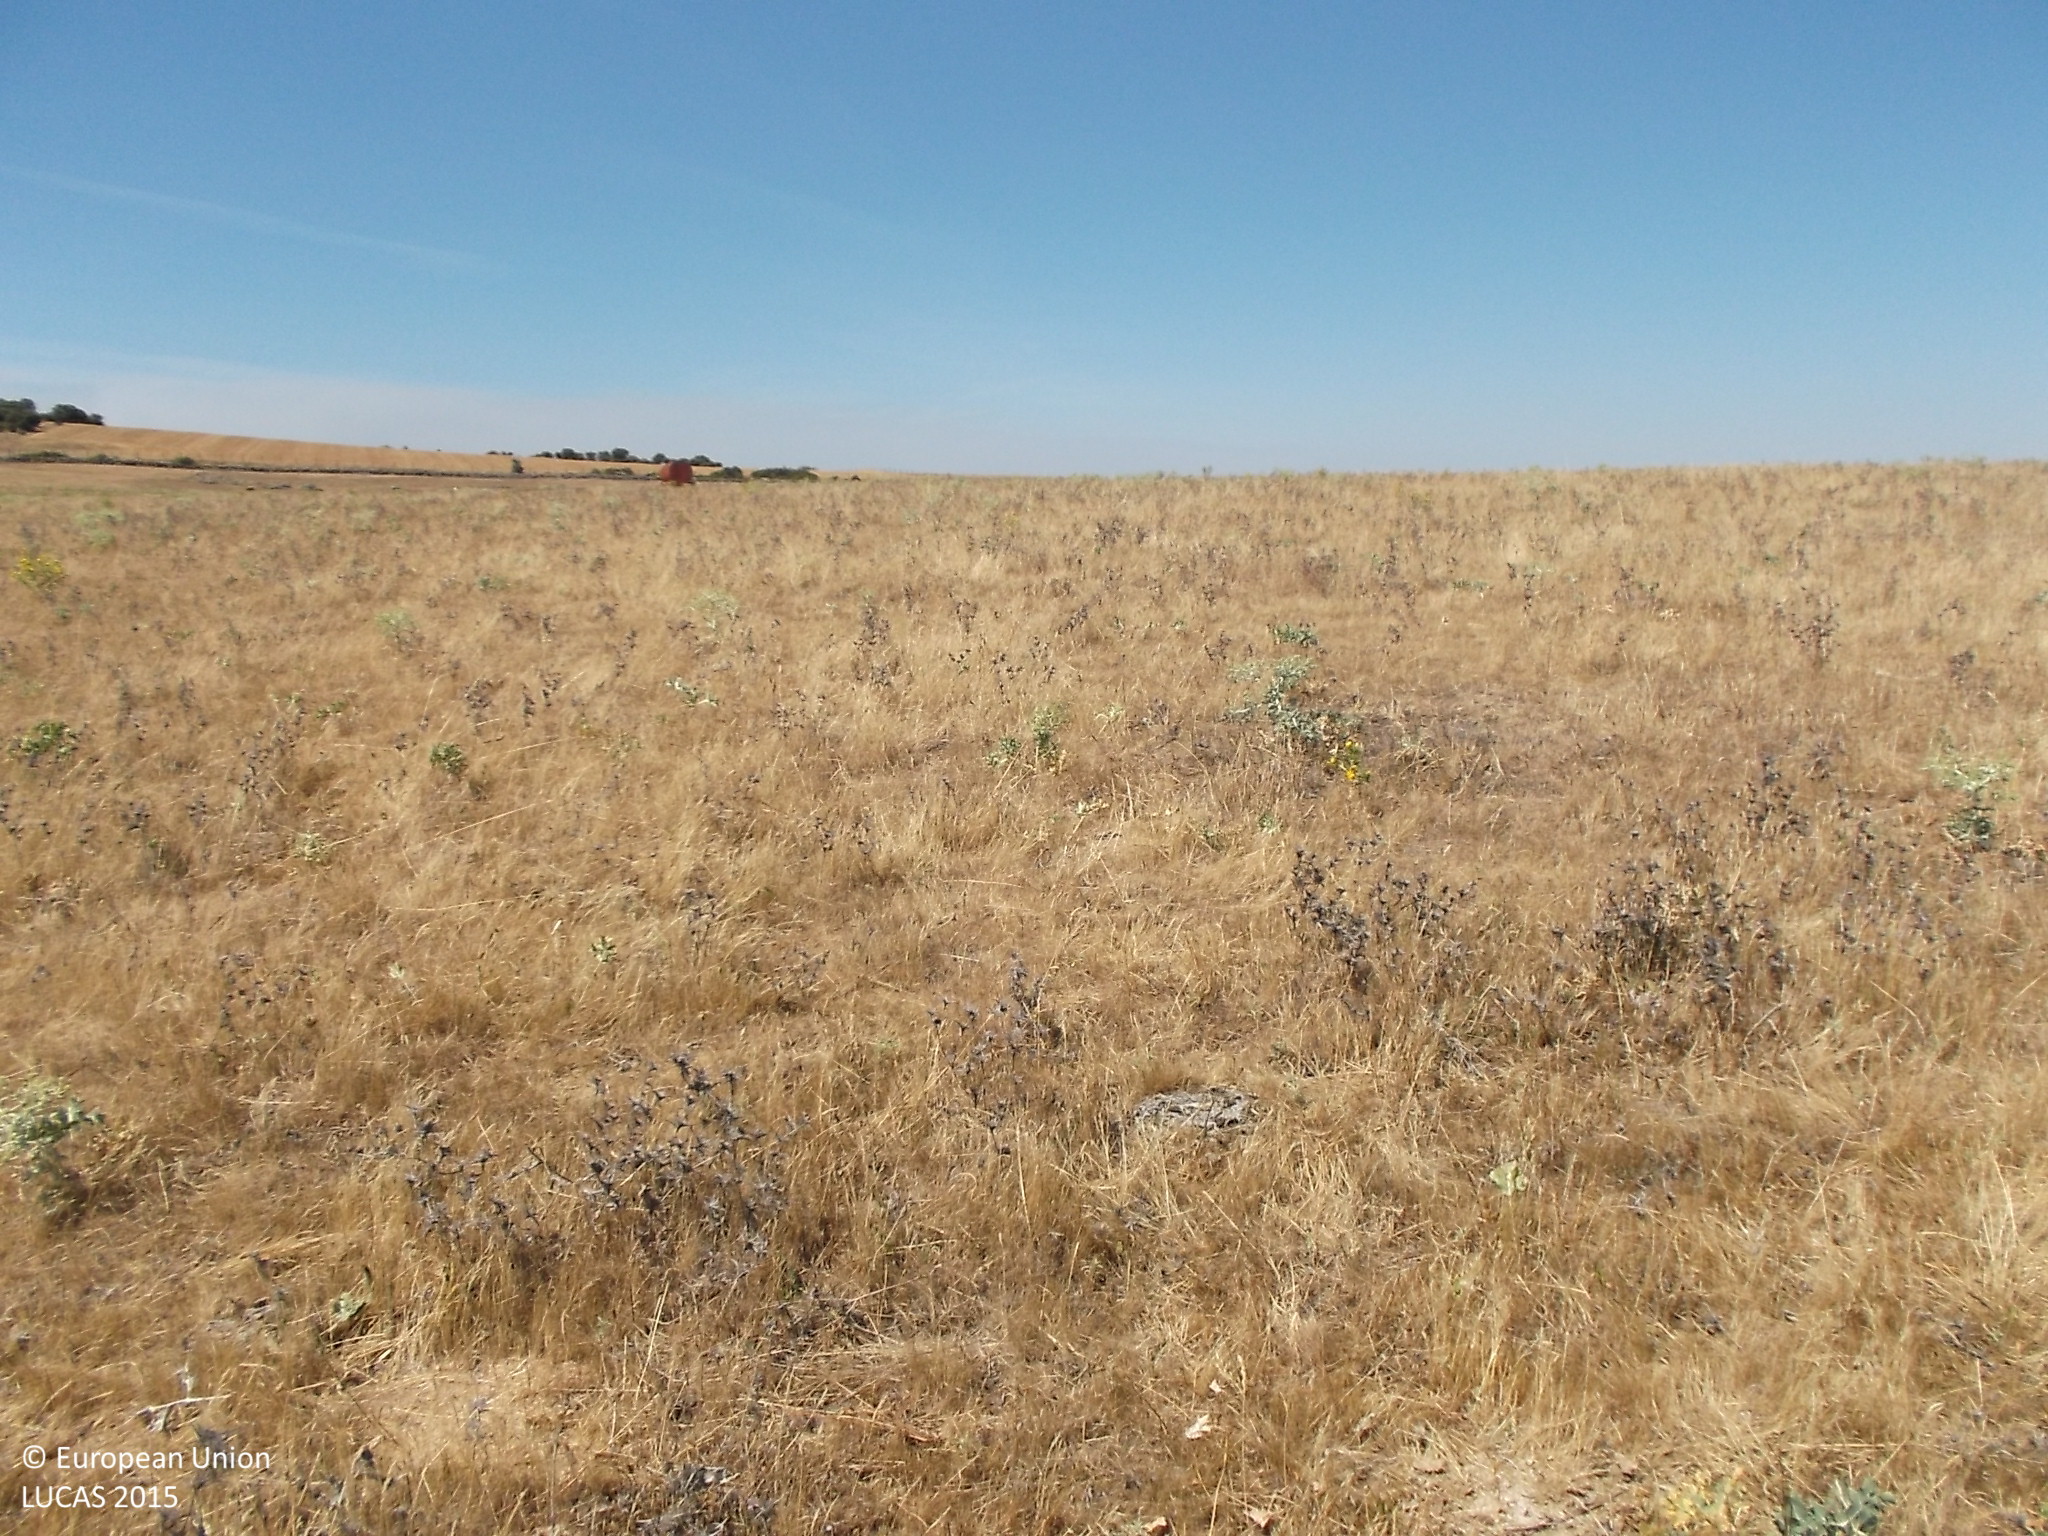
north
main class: Grassland
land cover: Grassland without tree/shrub cover
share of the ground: > 75 %
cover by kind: herbaceous plants 100 %
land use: Agriculture (excluding fallow land and kitchen gardens)
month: July
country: ES
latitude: 40.7309
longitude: -6.7564
